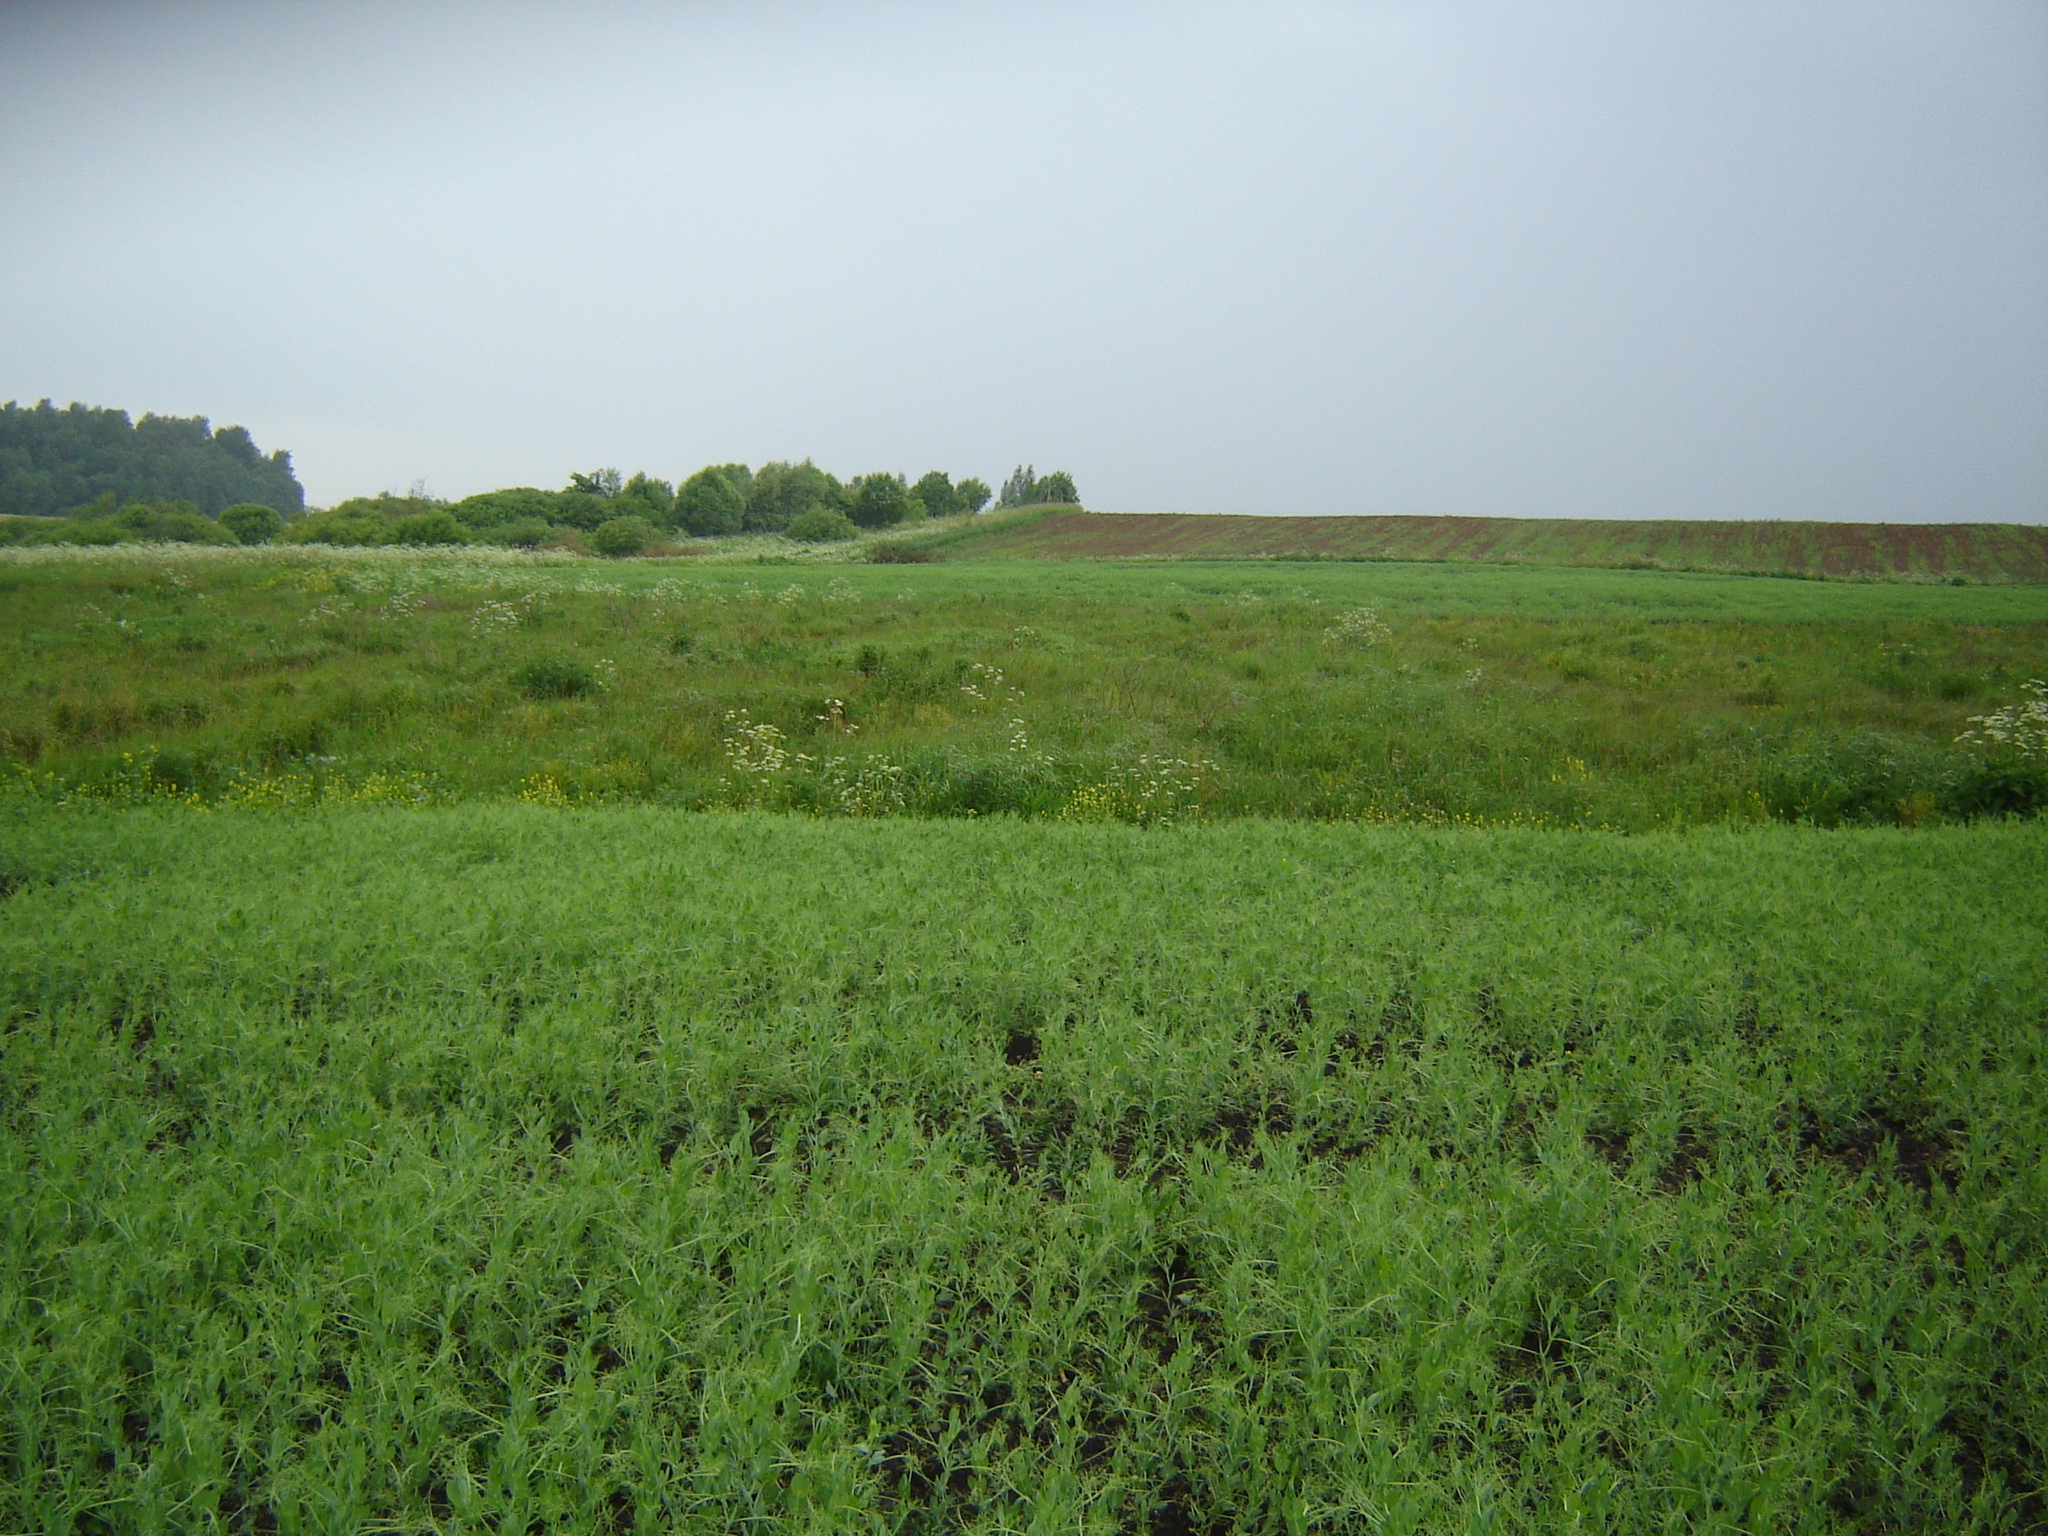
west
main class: Cropland
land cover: Dry pulses
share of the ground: > 75 %
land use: Agriculture (excluding fallow land and kitchen gardens)
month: June
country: LT
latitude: 55.5606
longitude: 25.2596
